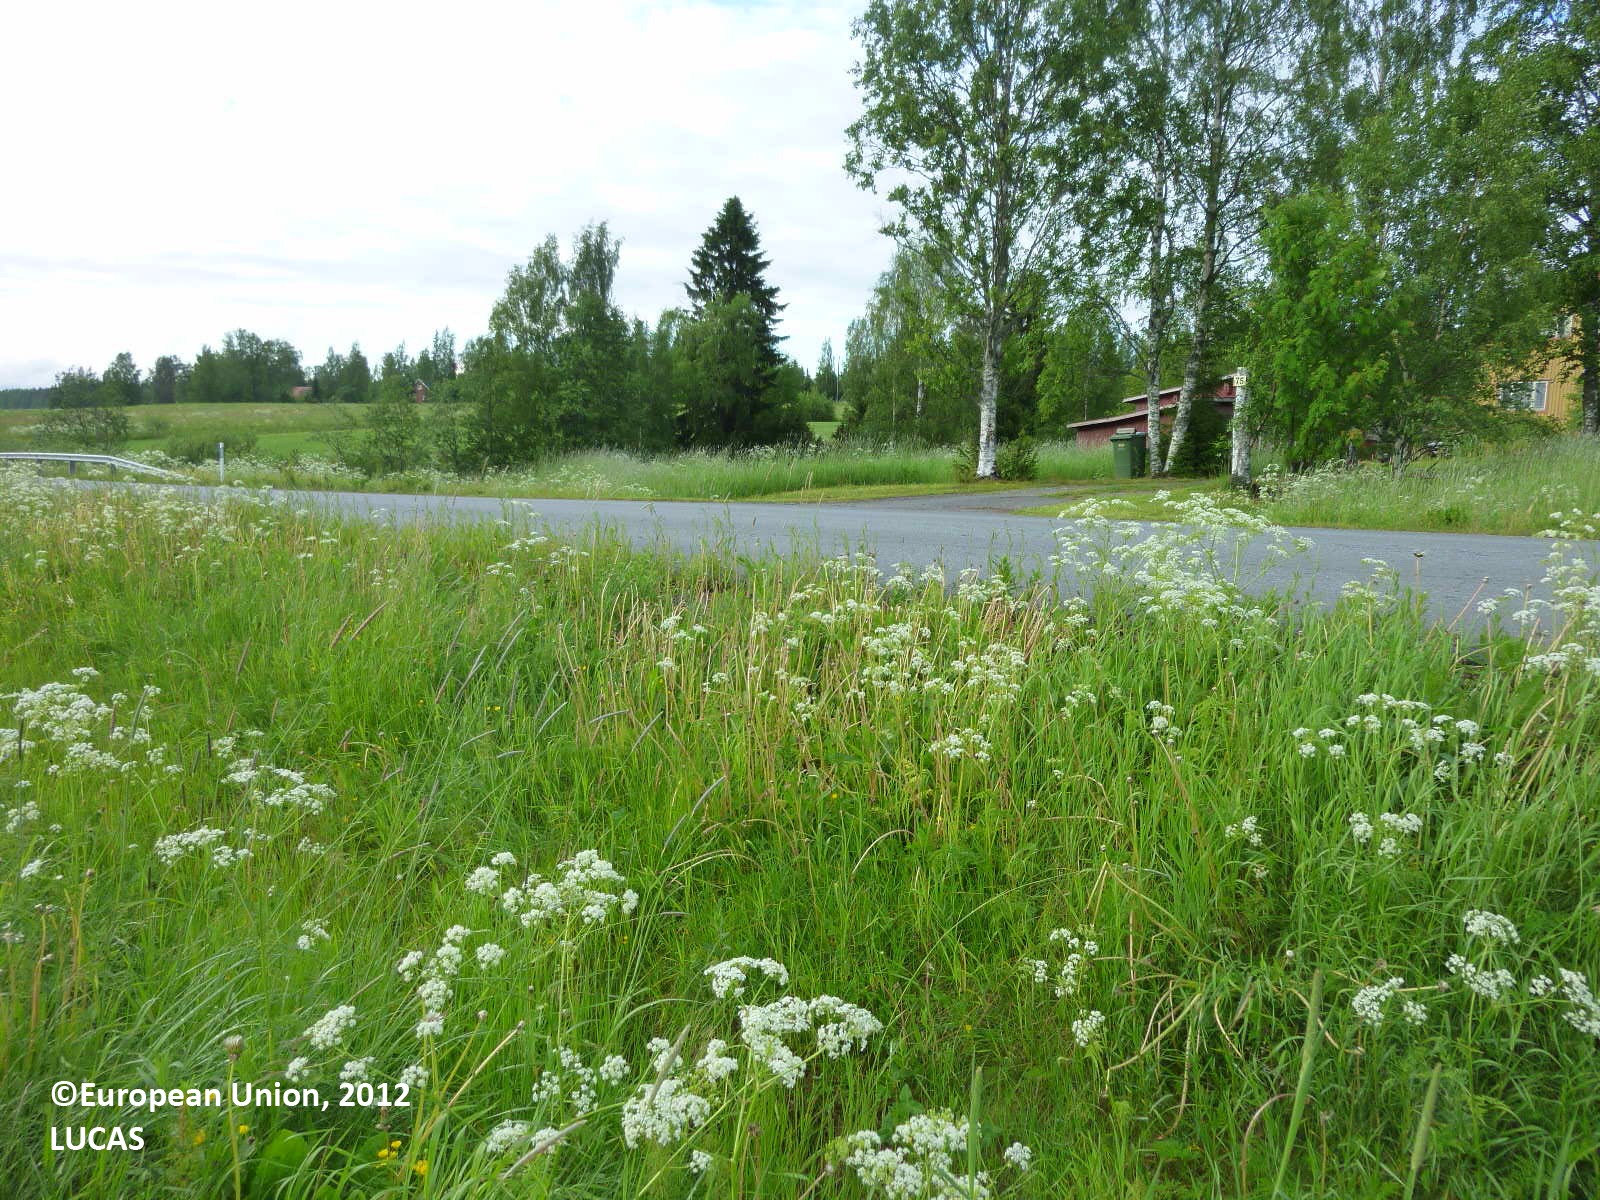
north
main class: Cropland
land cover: Barley
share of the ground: 50 - 75 %
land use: Agriculture (excluding fallow land and kitchen gardens)
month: June
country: FI
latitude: 61.6322
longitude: 22.4956
